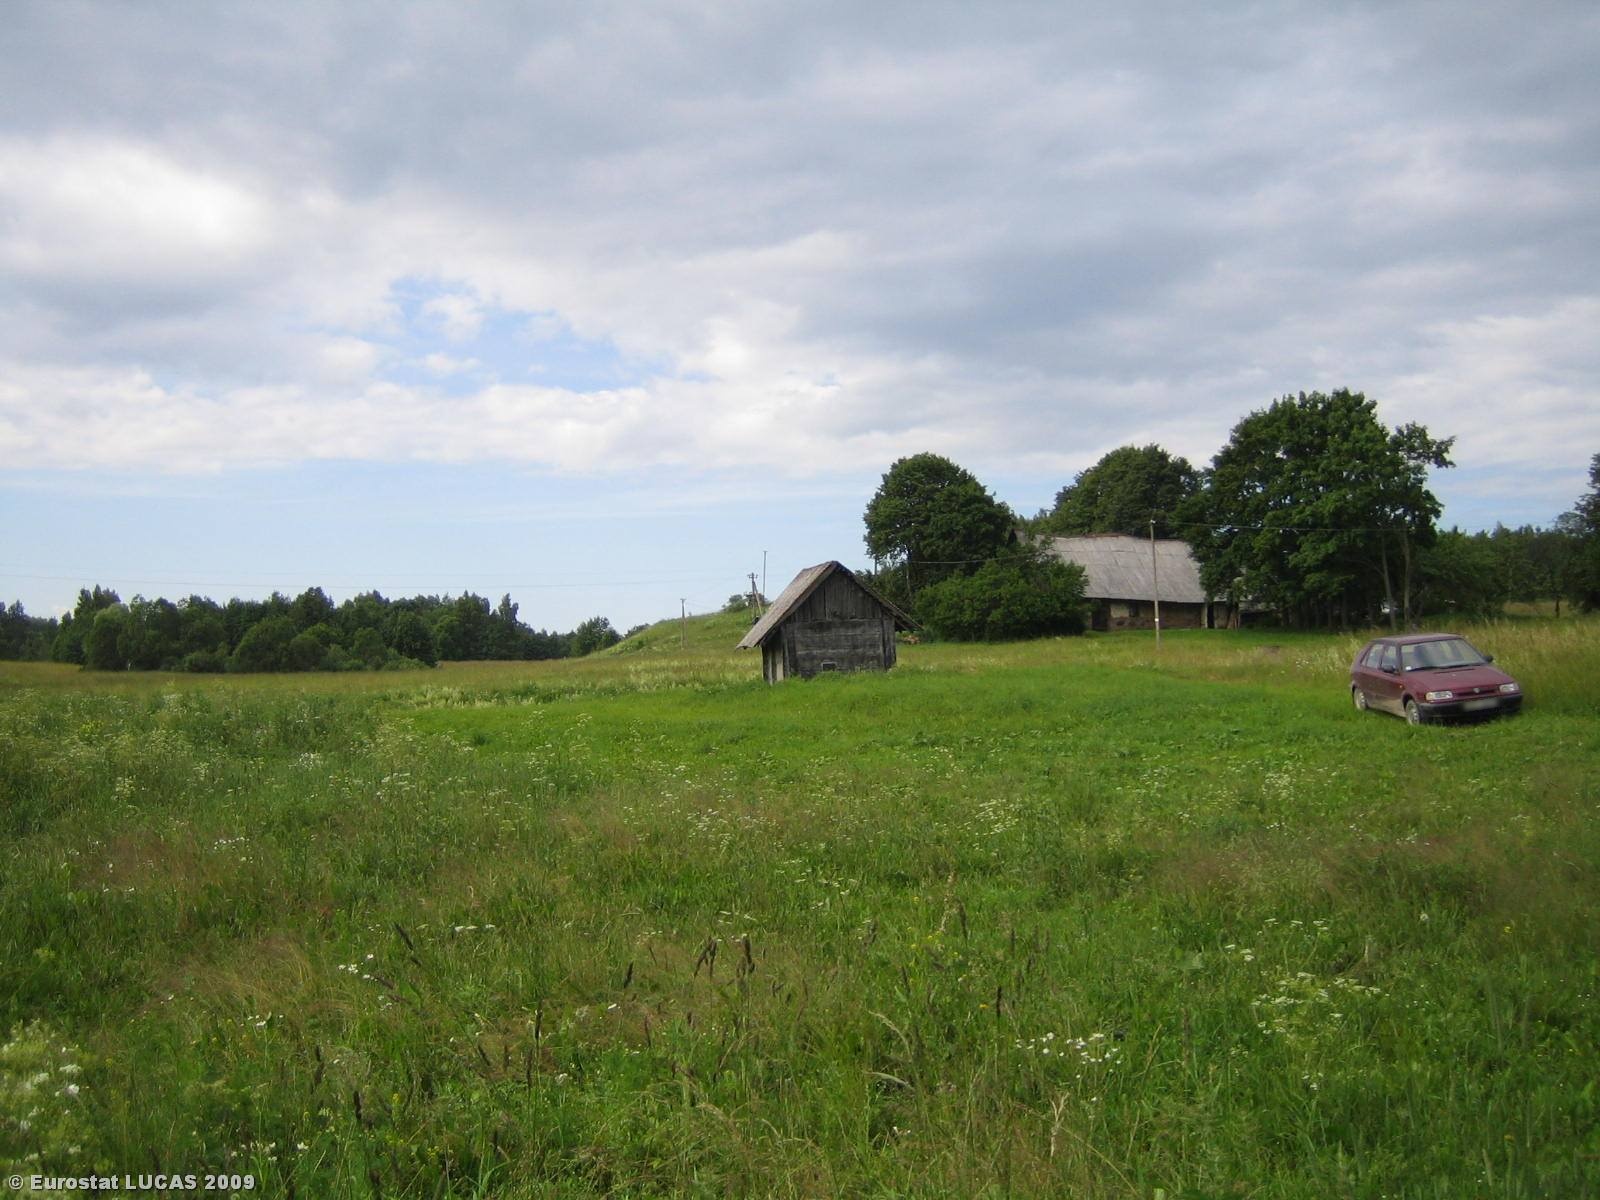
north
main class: Grassland
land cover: Grassland without tree/shrub cover
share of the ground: > 75 %
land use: Agriculture (excluding fallow land and kitchen gardens)
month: July
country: LT
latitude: 55.5785
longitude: 25.8530
